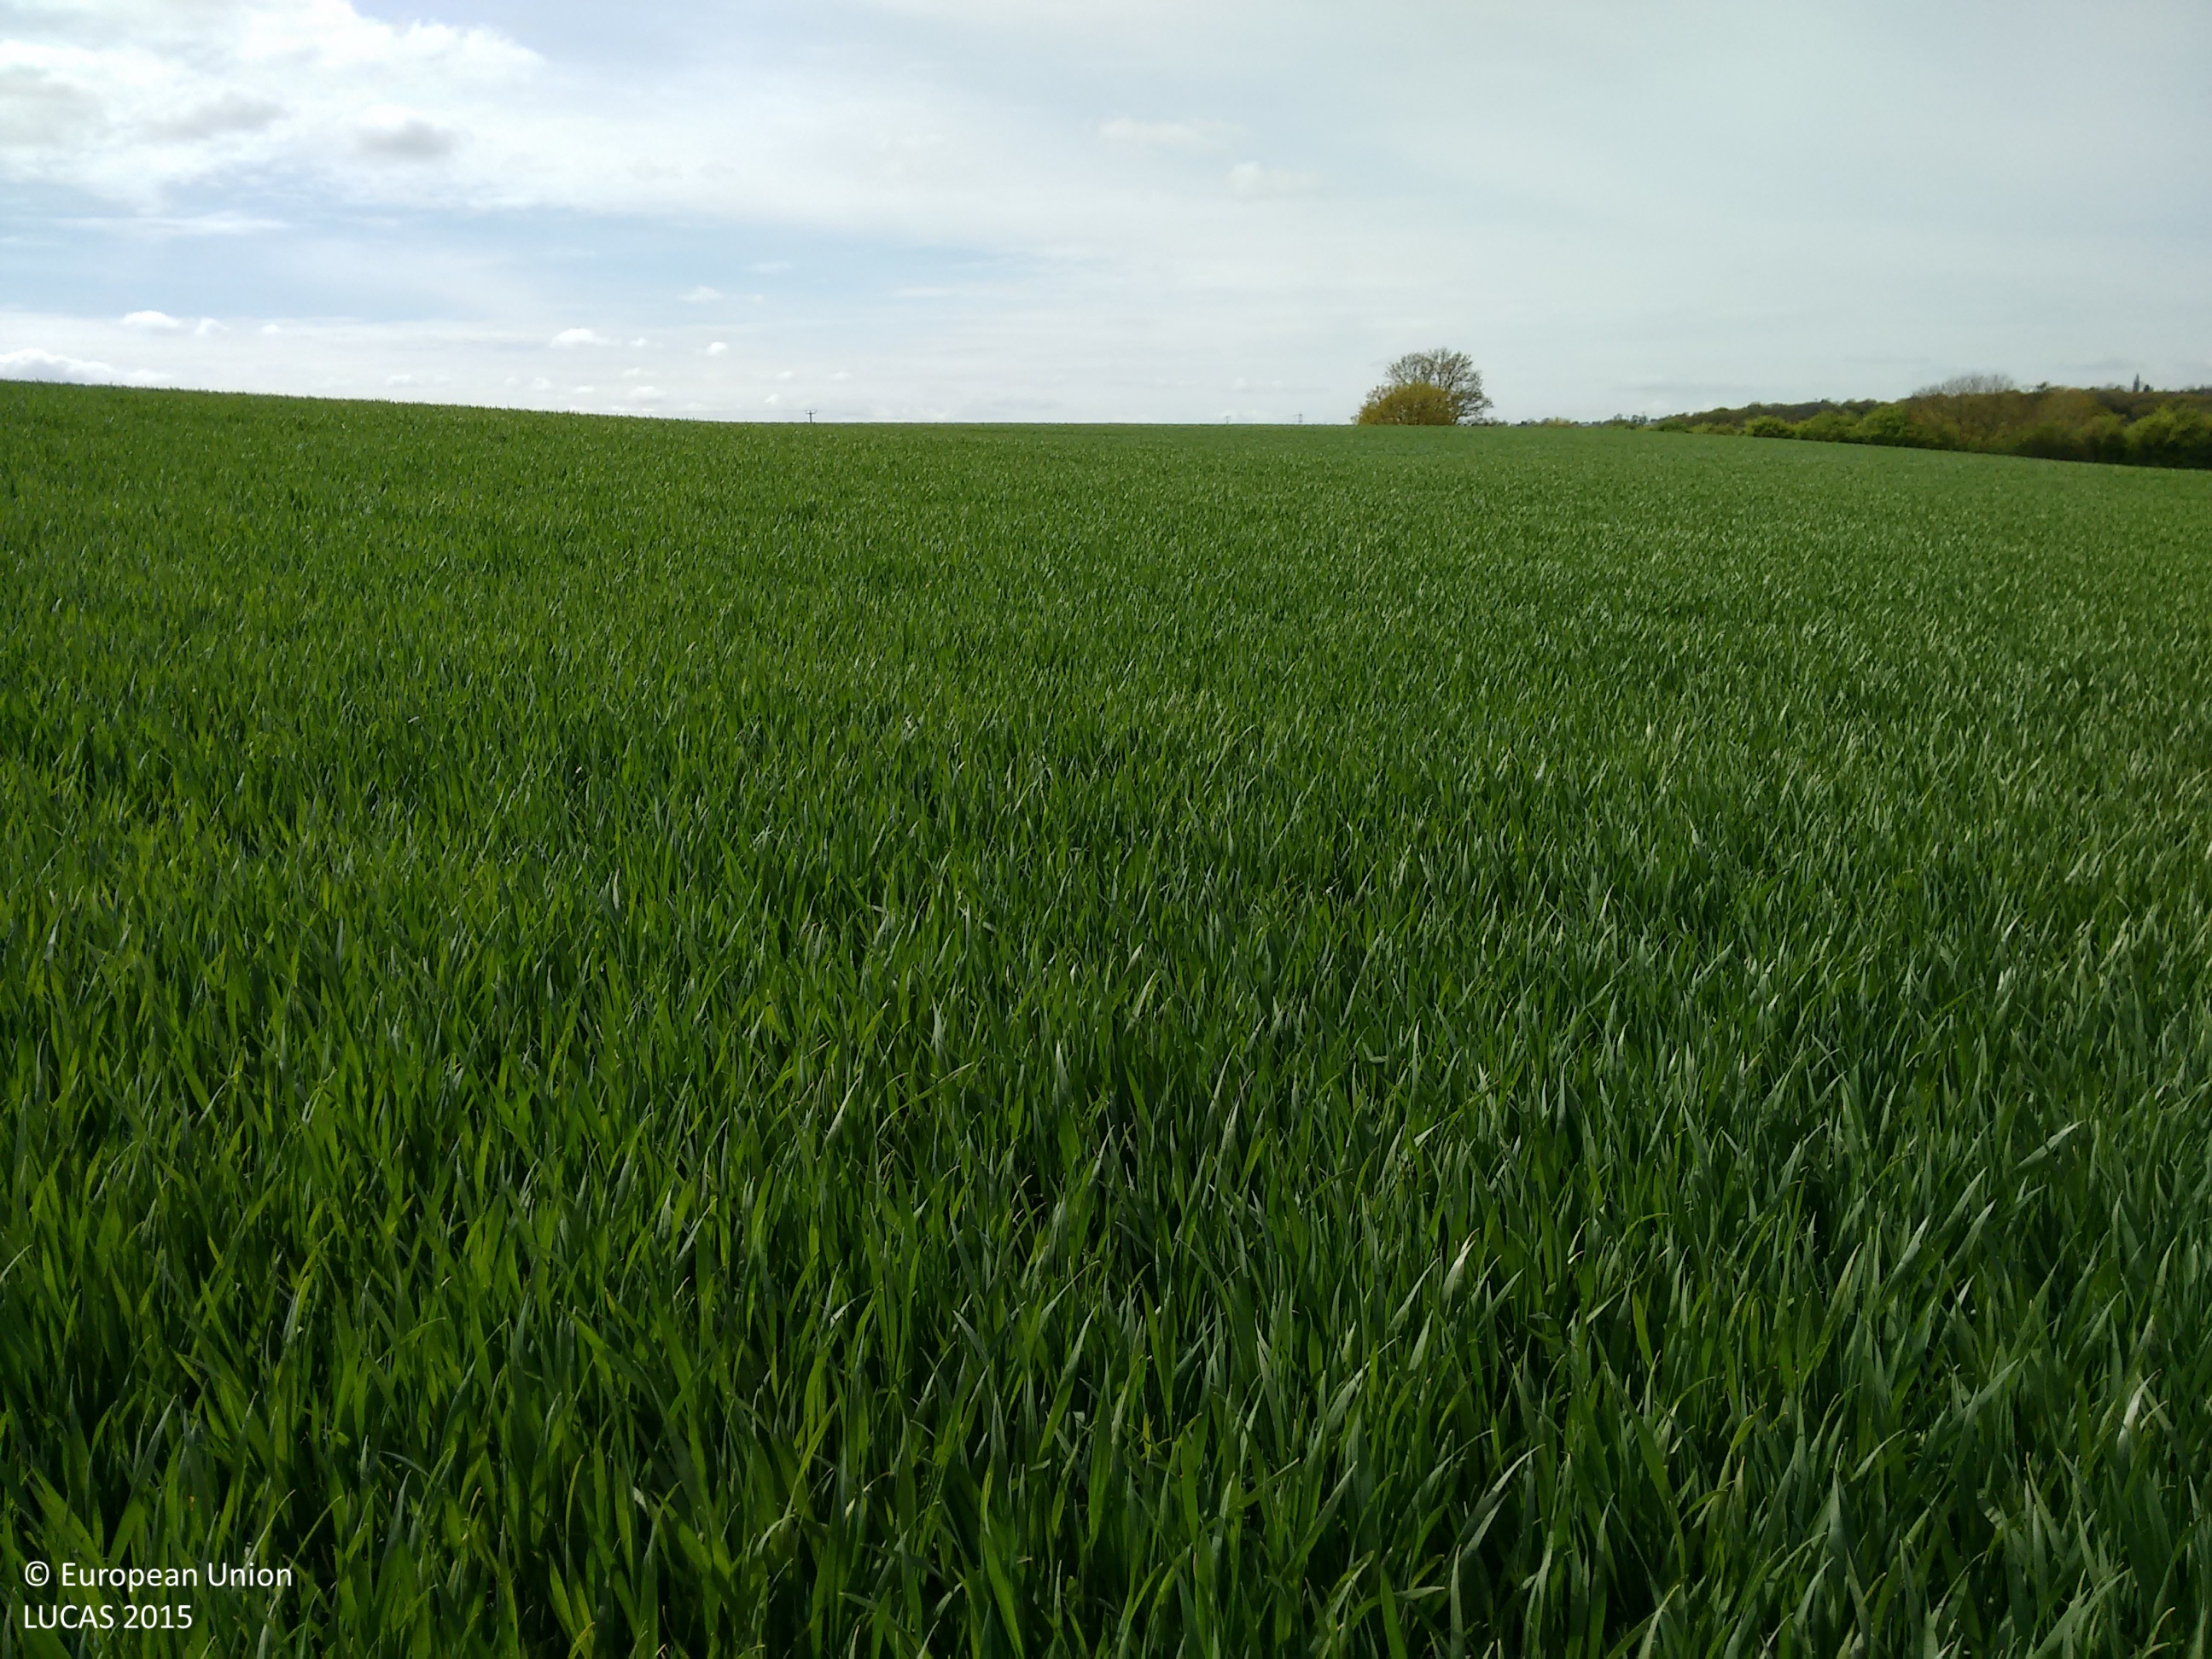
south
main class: Cropland
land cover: Common wheat
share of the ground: > 75 %
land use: Agriculture (excluding fallow land and kitchen gardens)
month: May
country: GB
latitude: 52.2660
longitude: -1.9113
